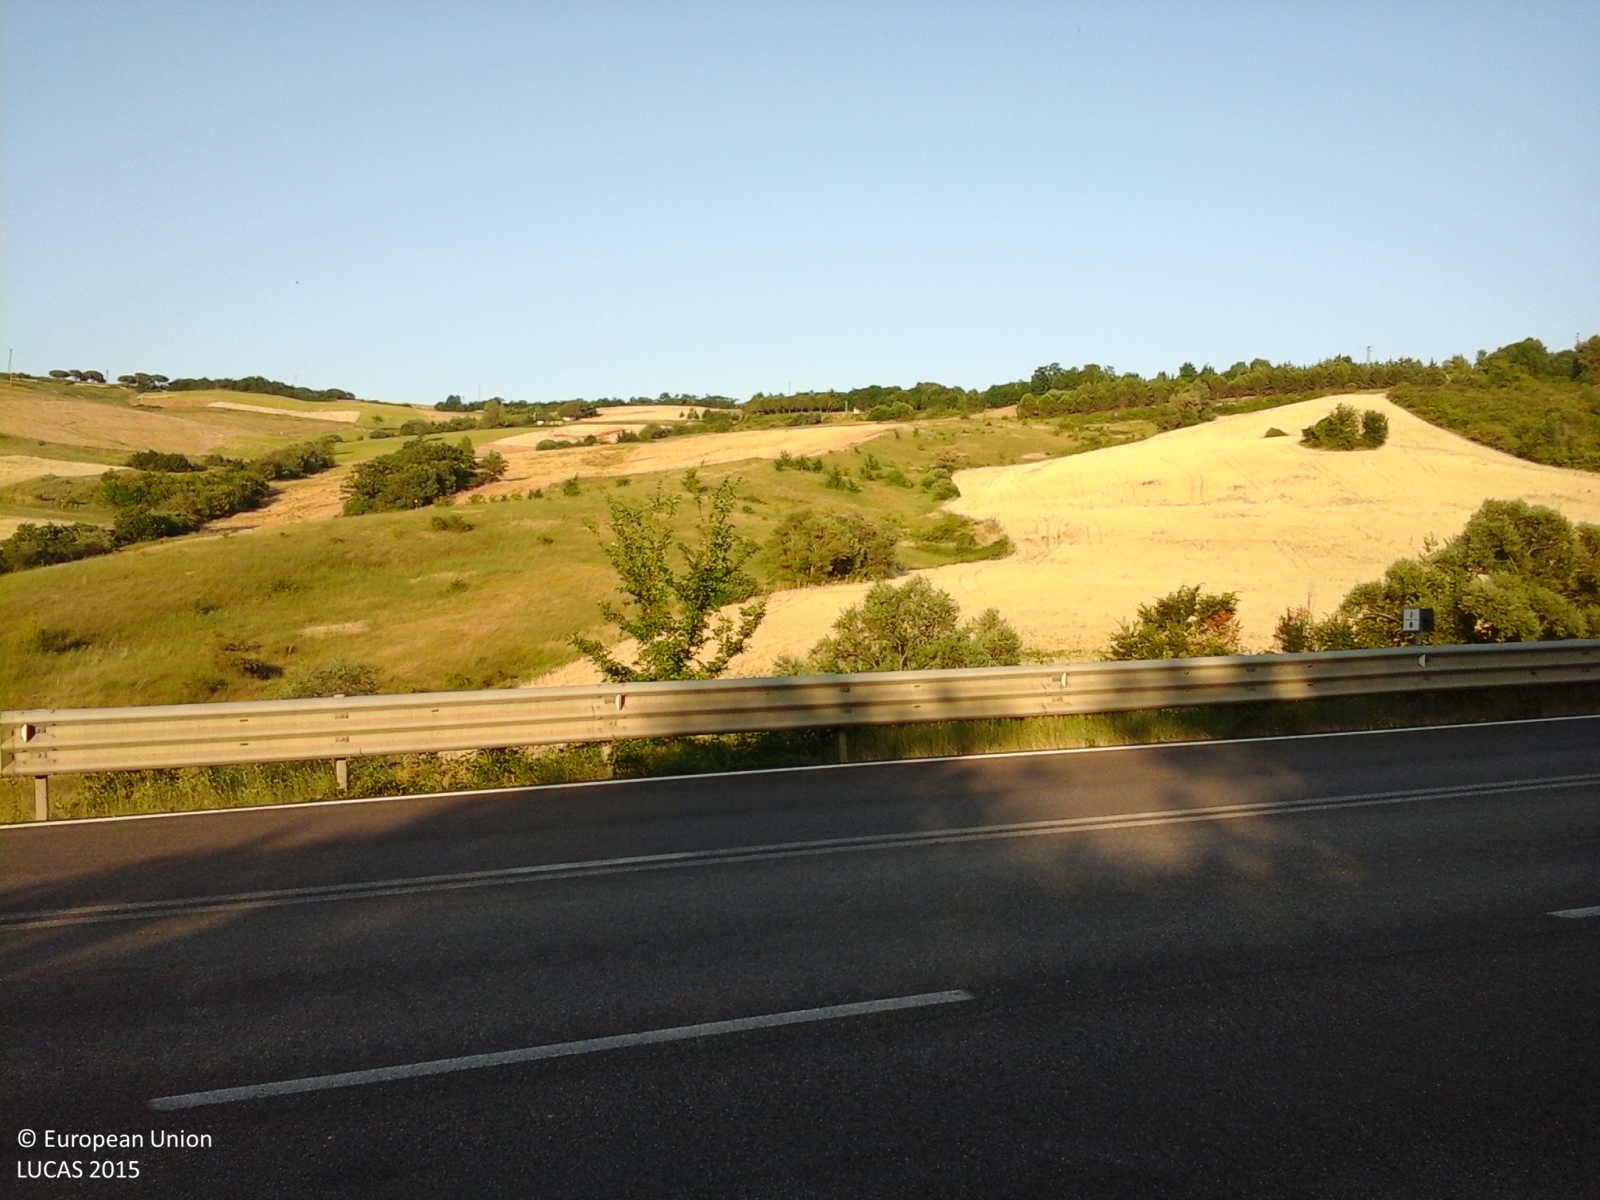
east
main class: Woodland
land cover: Broadleaved woodland
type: thermophilous deciduous forest
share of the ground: > 75 %
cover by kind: broadleaved forest trees 90 %, shrubs 10 %
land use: Semi-natural and natural areas not in use
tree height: > 5 m
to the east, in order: Broadleaved woodland; Paved roads, cycling and walking lanes; Broadleaved woodland; Durum wheat; Grassland with sparse tree/shrub cover
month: July
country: IT
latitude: 41.6051
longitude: 14.6755
